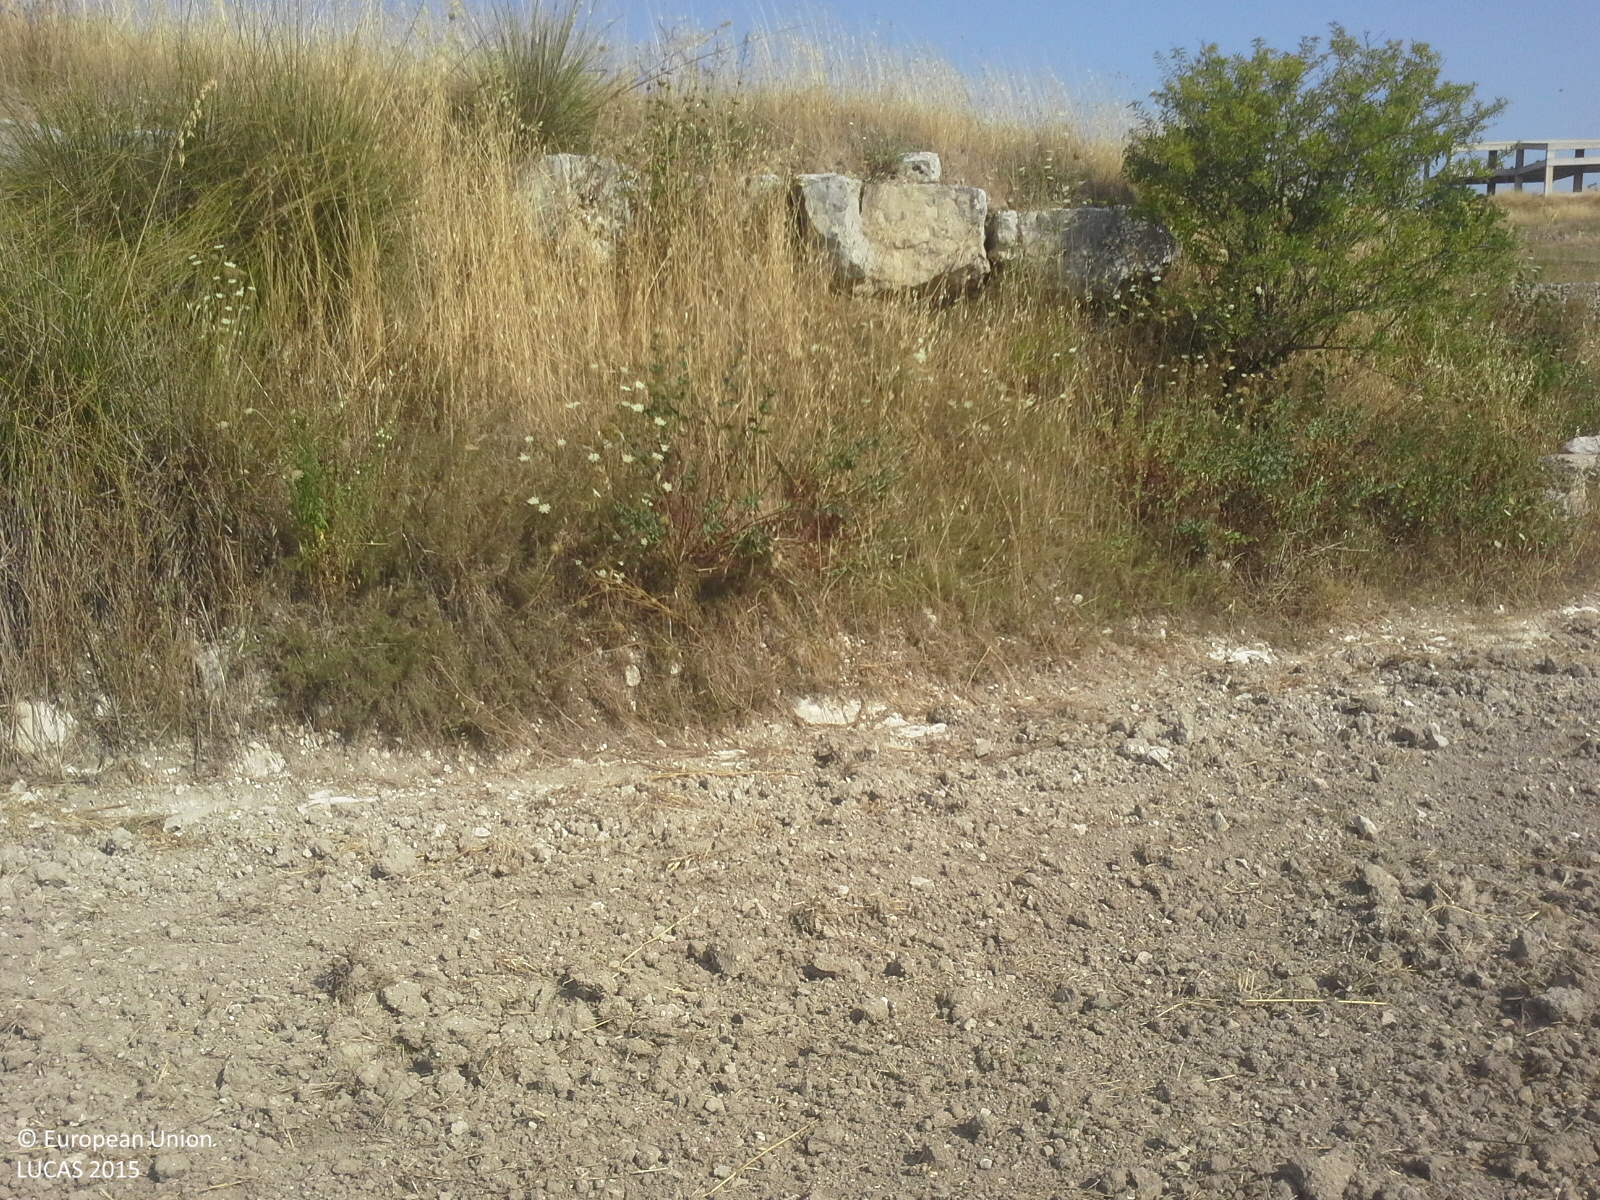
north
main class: Grassland
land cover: Grassland without tree/shrub cover
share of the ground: > 75 %
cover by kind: herbaceous plants 100 %
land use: Semi-natural and natural areas not in use
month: July
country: IT
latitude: 36.9543
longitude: 14.7801
